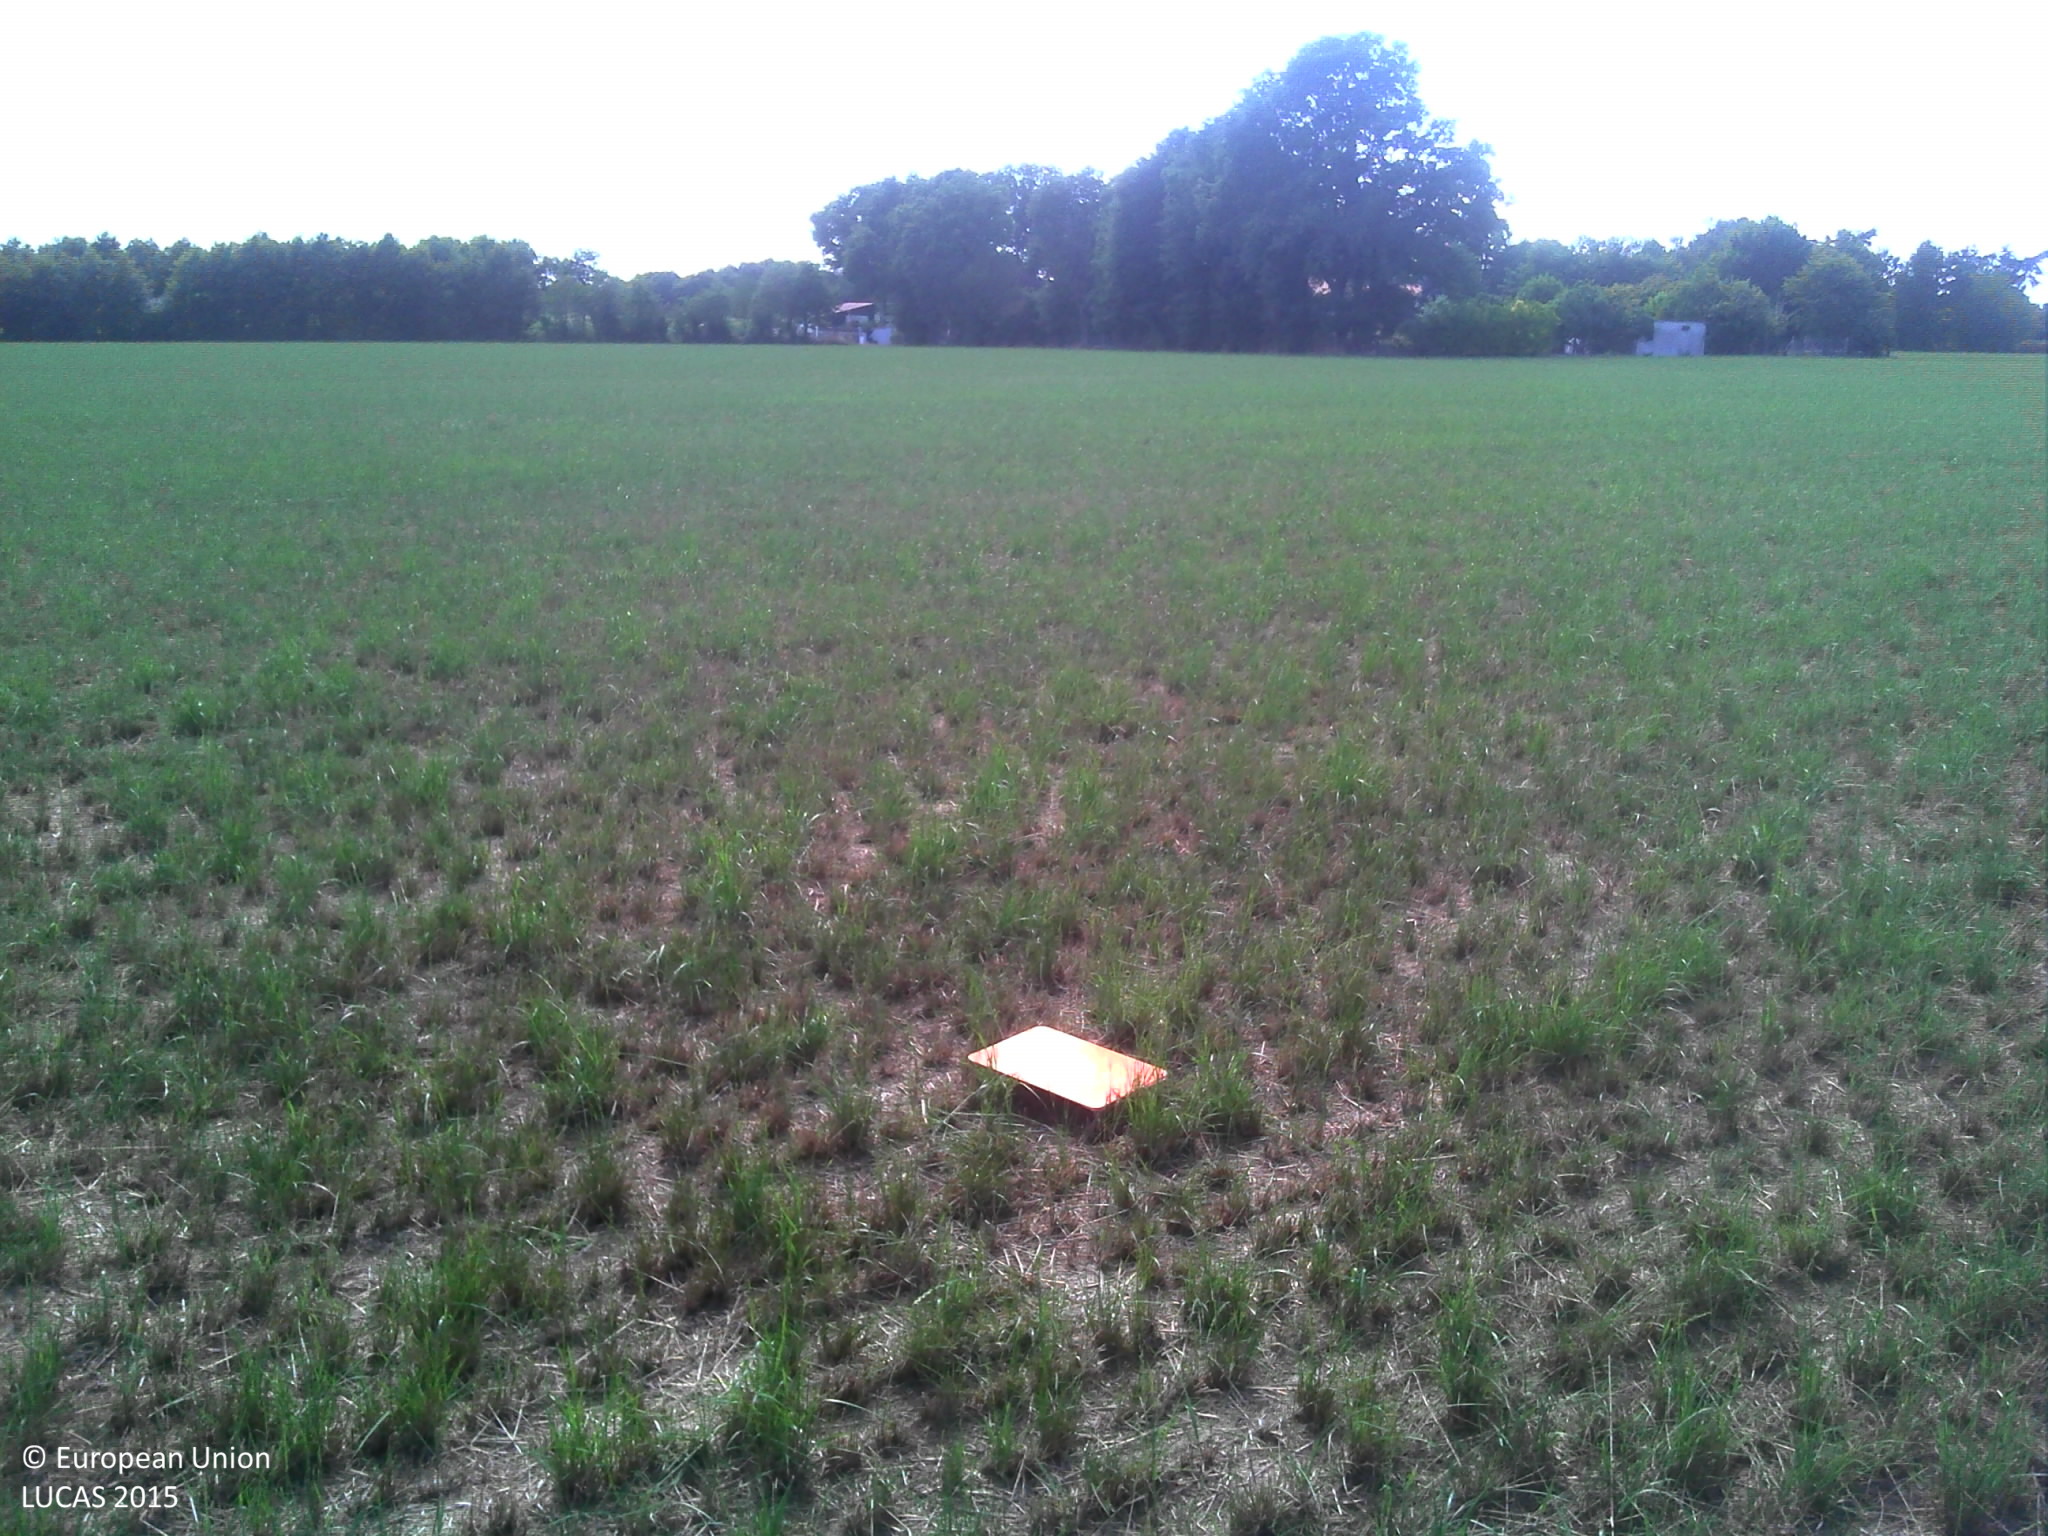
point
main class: Cropland
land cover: Temporary grasslands
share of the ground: > 75 %
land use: Agriculture (excluding fallow land and kitchen gardens)
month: August
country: FR
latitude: 46.7288
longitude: -1.3294
